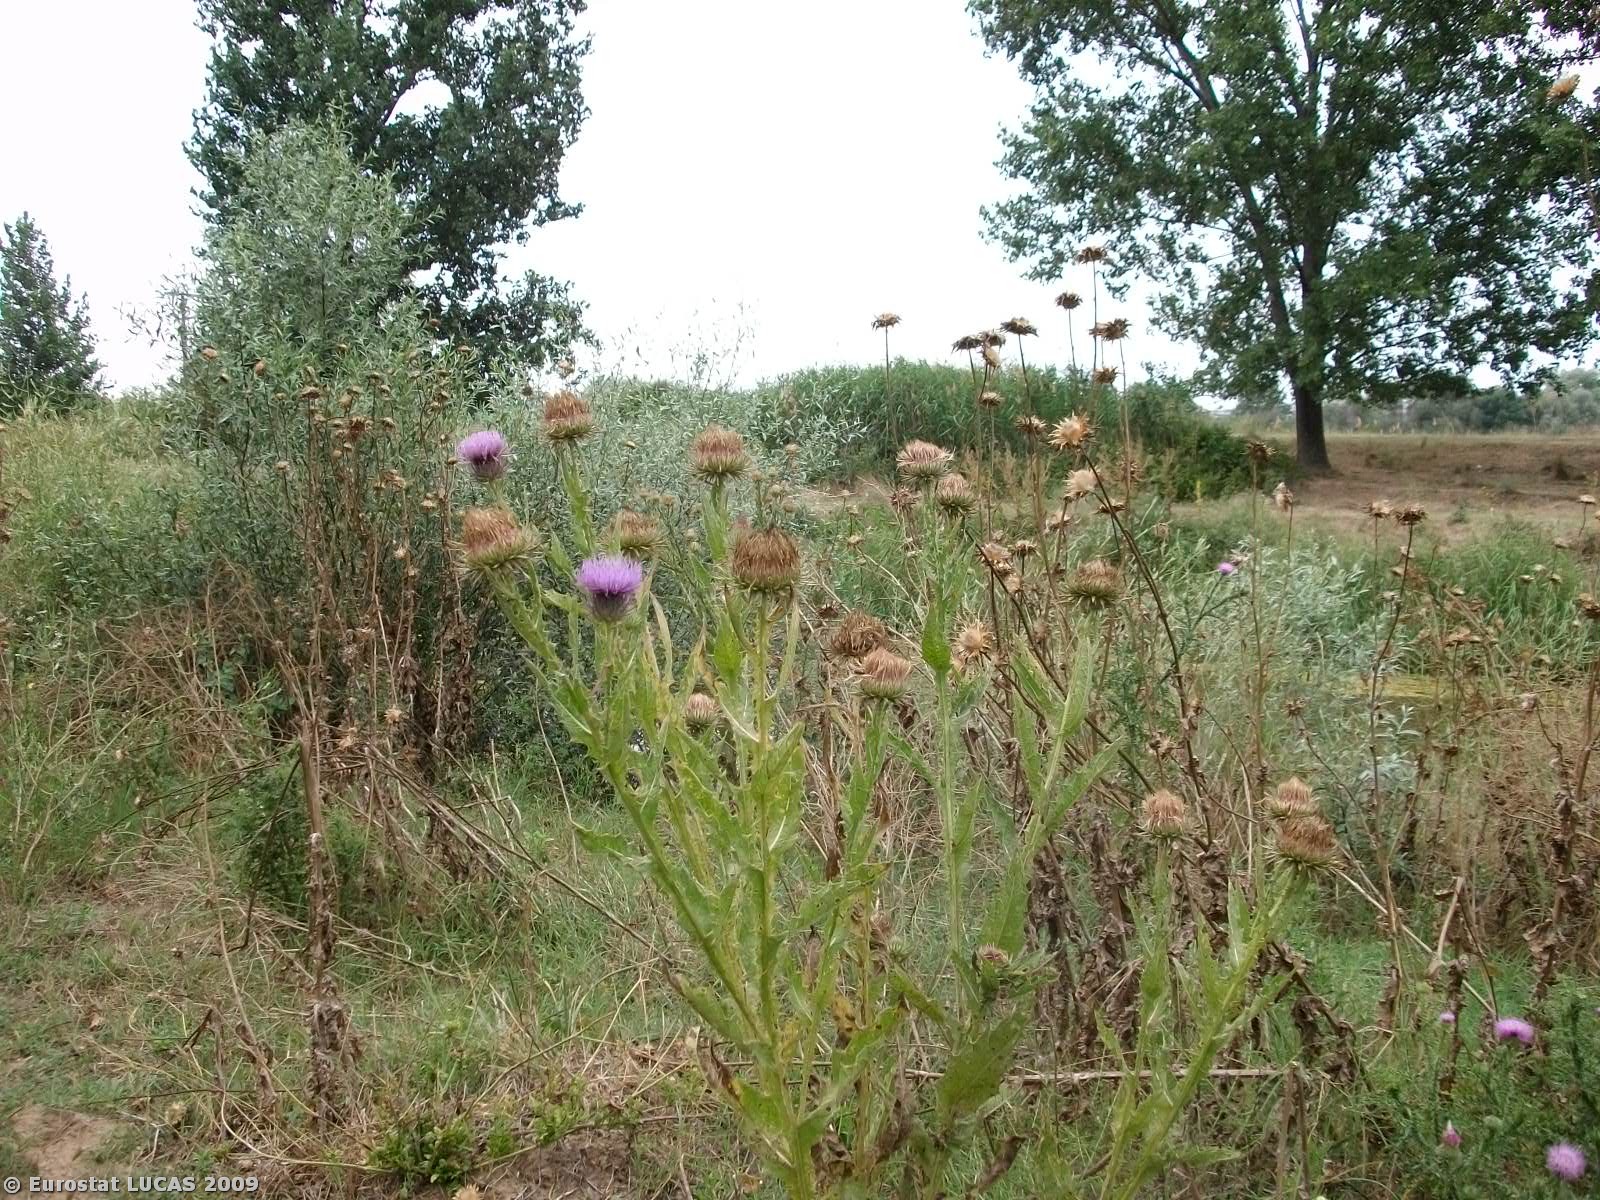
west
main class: Woodland
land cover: Broadleaved woodland
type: broadleaved evergreen forest
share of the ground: > 75 %
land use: Forestry
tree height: > 5 m
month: July
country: GR
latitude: 40.9168
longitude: 26.1999
